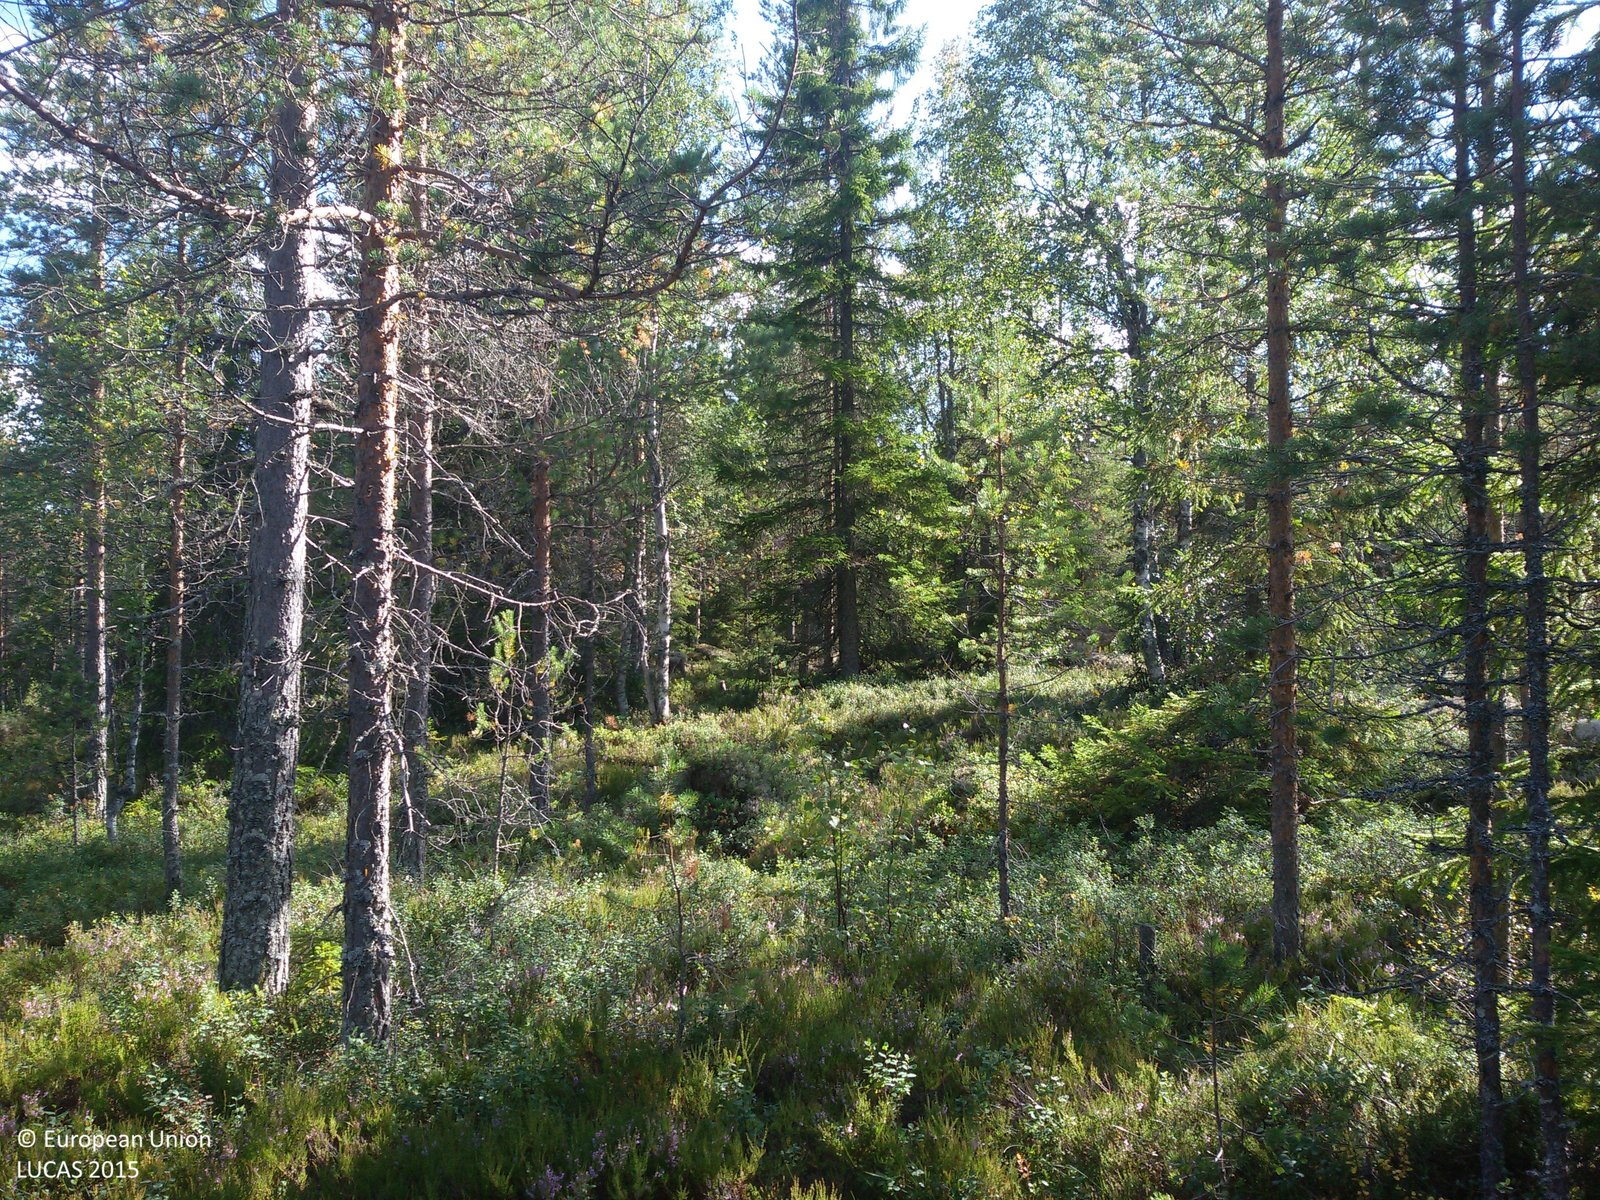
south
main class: Woodland
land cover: Pine dominated coniferous woodland
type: boreal forest
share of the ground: 50 - 75 %
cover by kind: coniferous forest trees 50 %, herbaceous plants 40 %, lichens and mosses 10 %
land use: Forestry
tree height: > 5 m
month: August
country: SE
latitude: 60.9224
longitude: 15.9443
